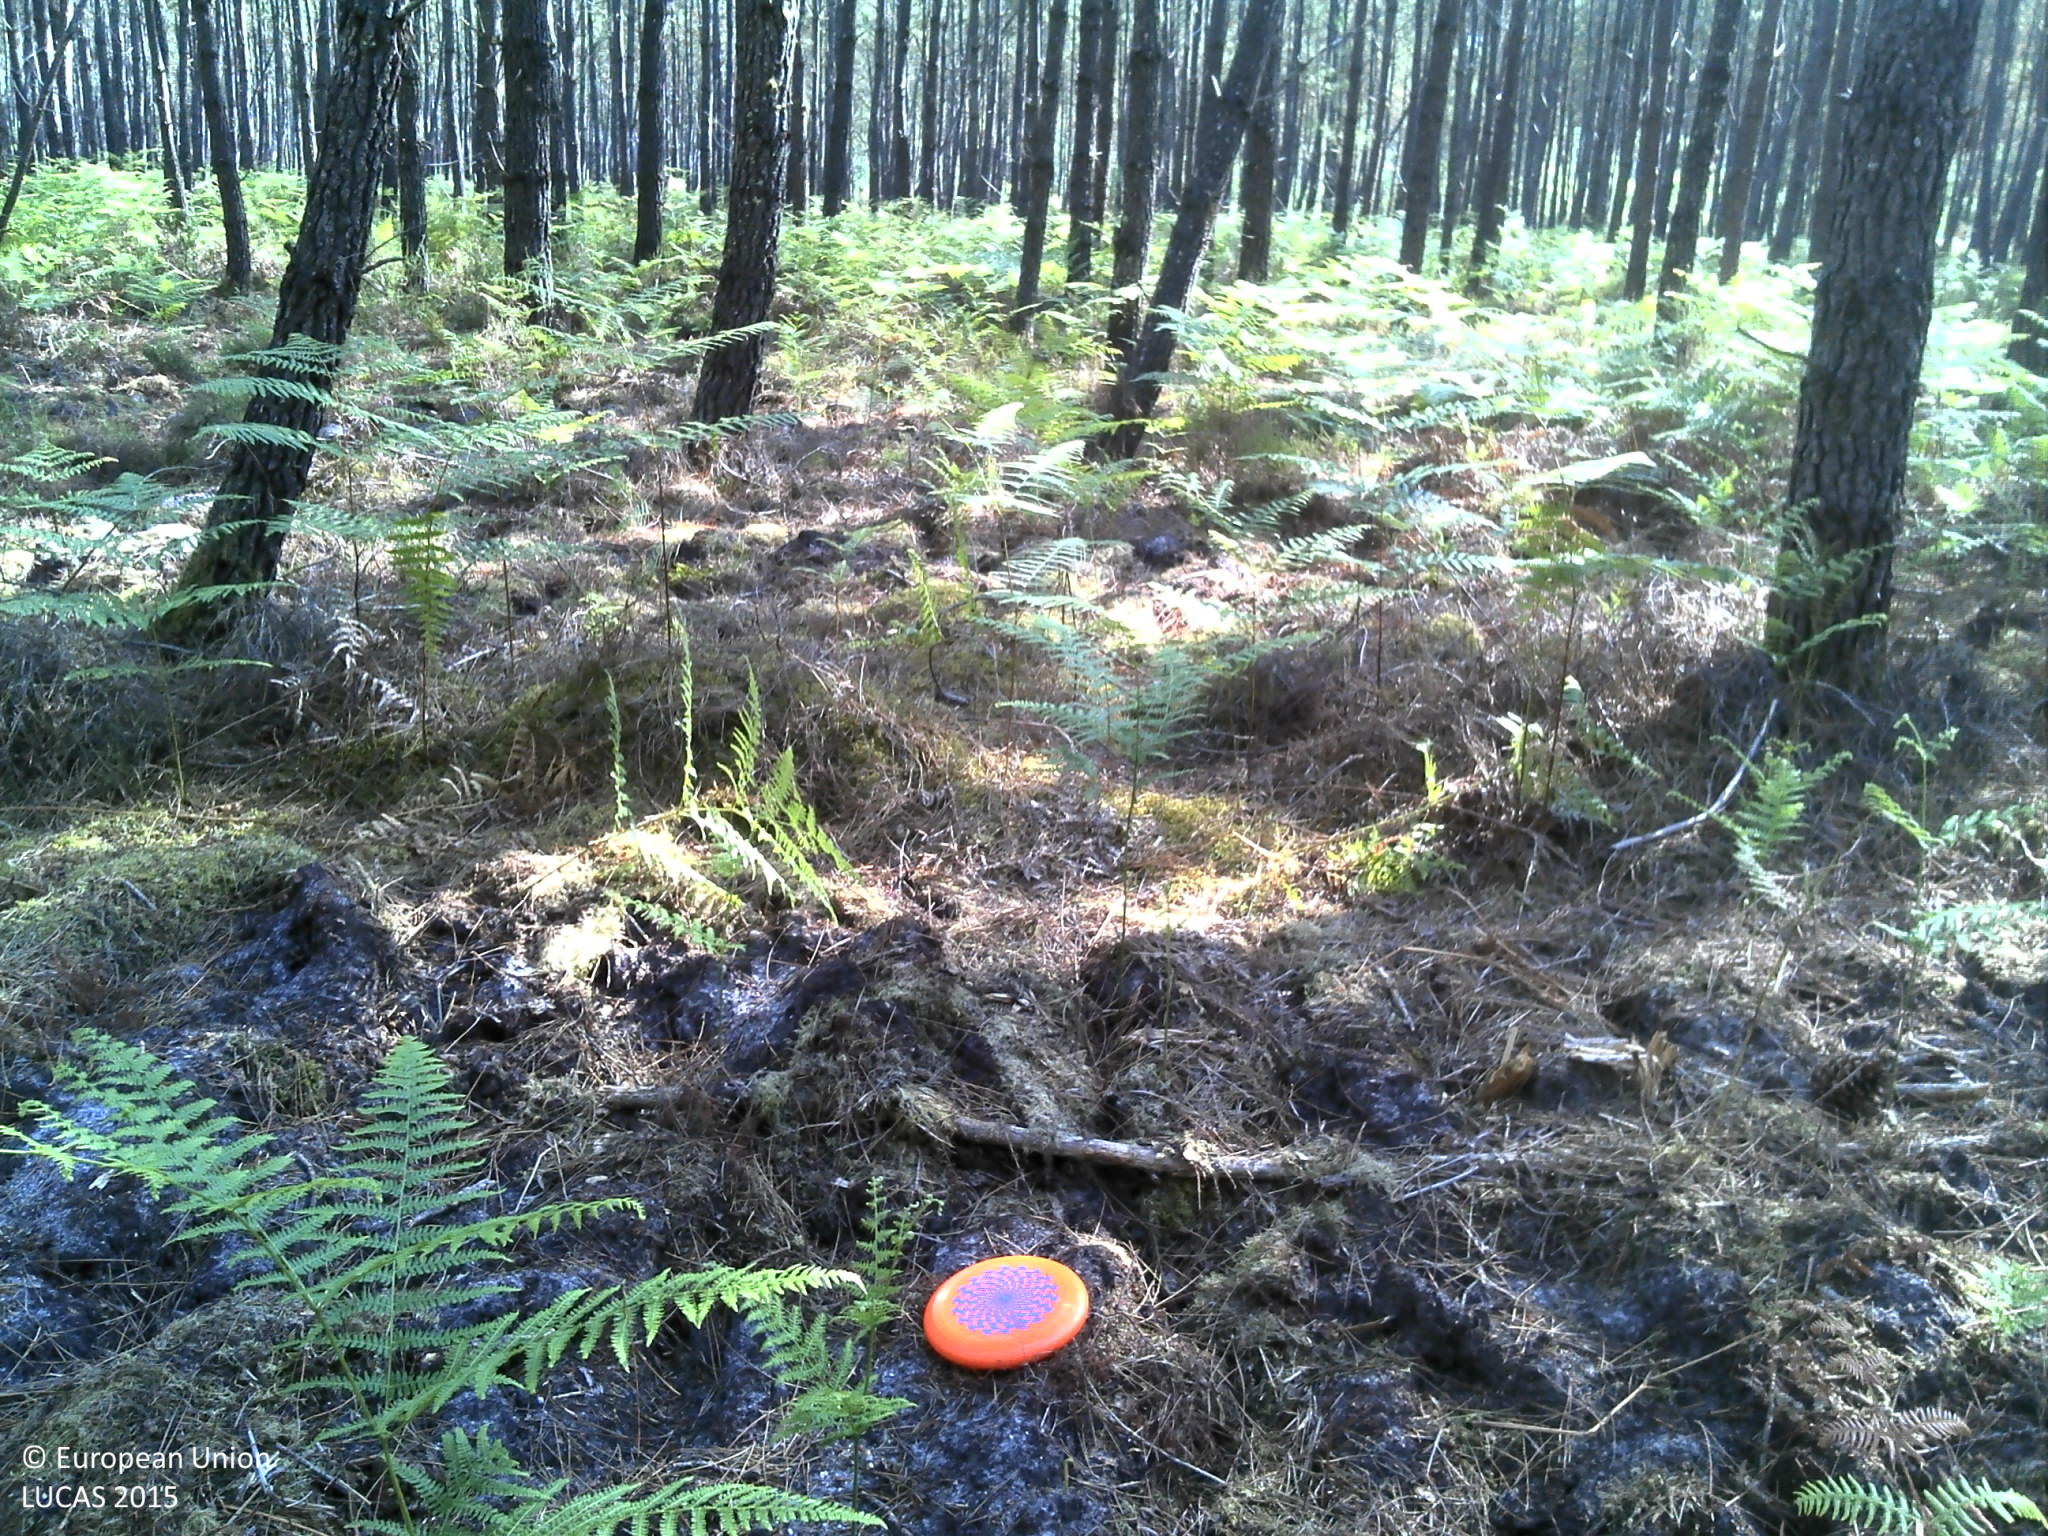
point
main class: Woodland
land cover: Pine dominated coniferous woodland
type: exotic forest
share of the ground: > 75 %
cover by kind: coniferous forest trees 75 %, shrubs 15 %, herbaceous plants 5 %, lichens and mosses 5 %
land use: Forestry
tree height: > 5 m
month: July
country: FR
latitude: 44.4285
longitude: -0.3776
